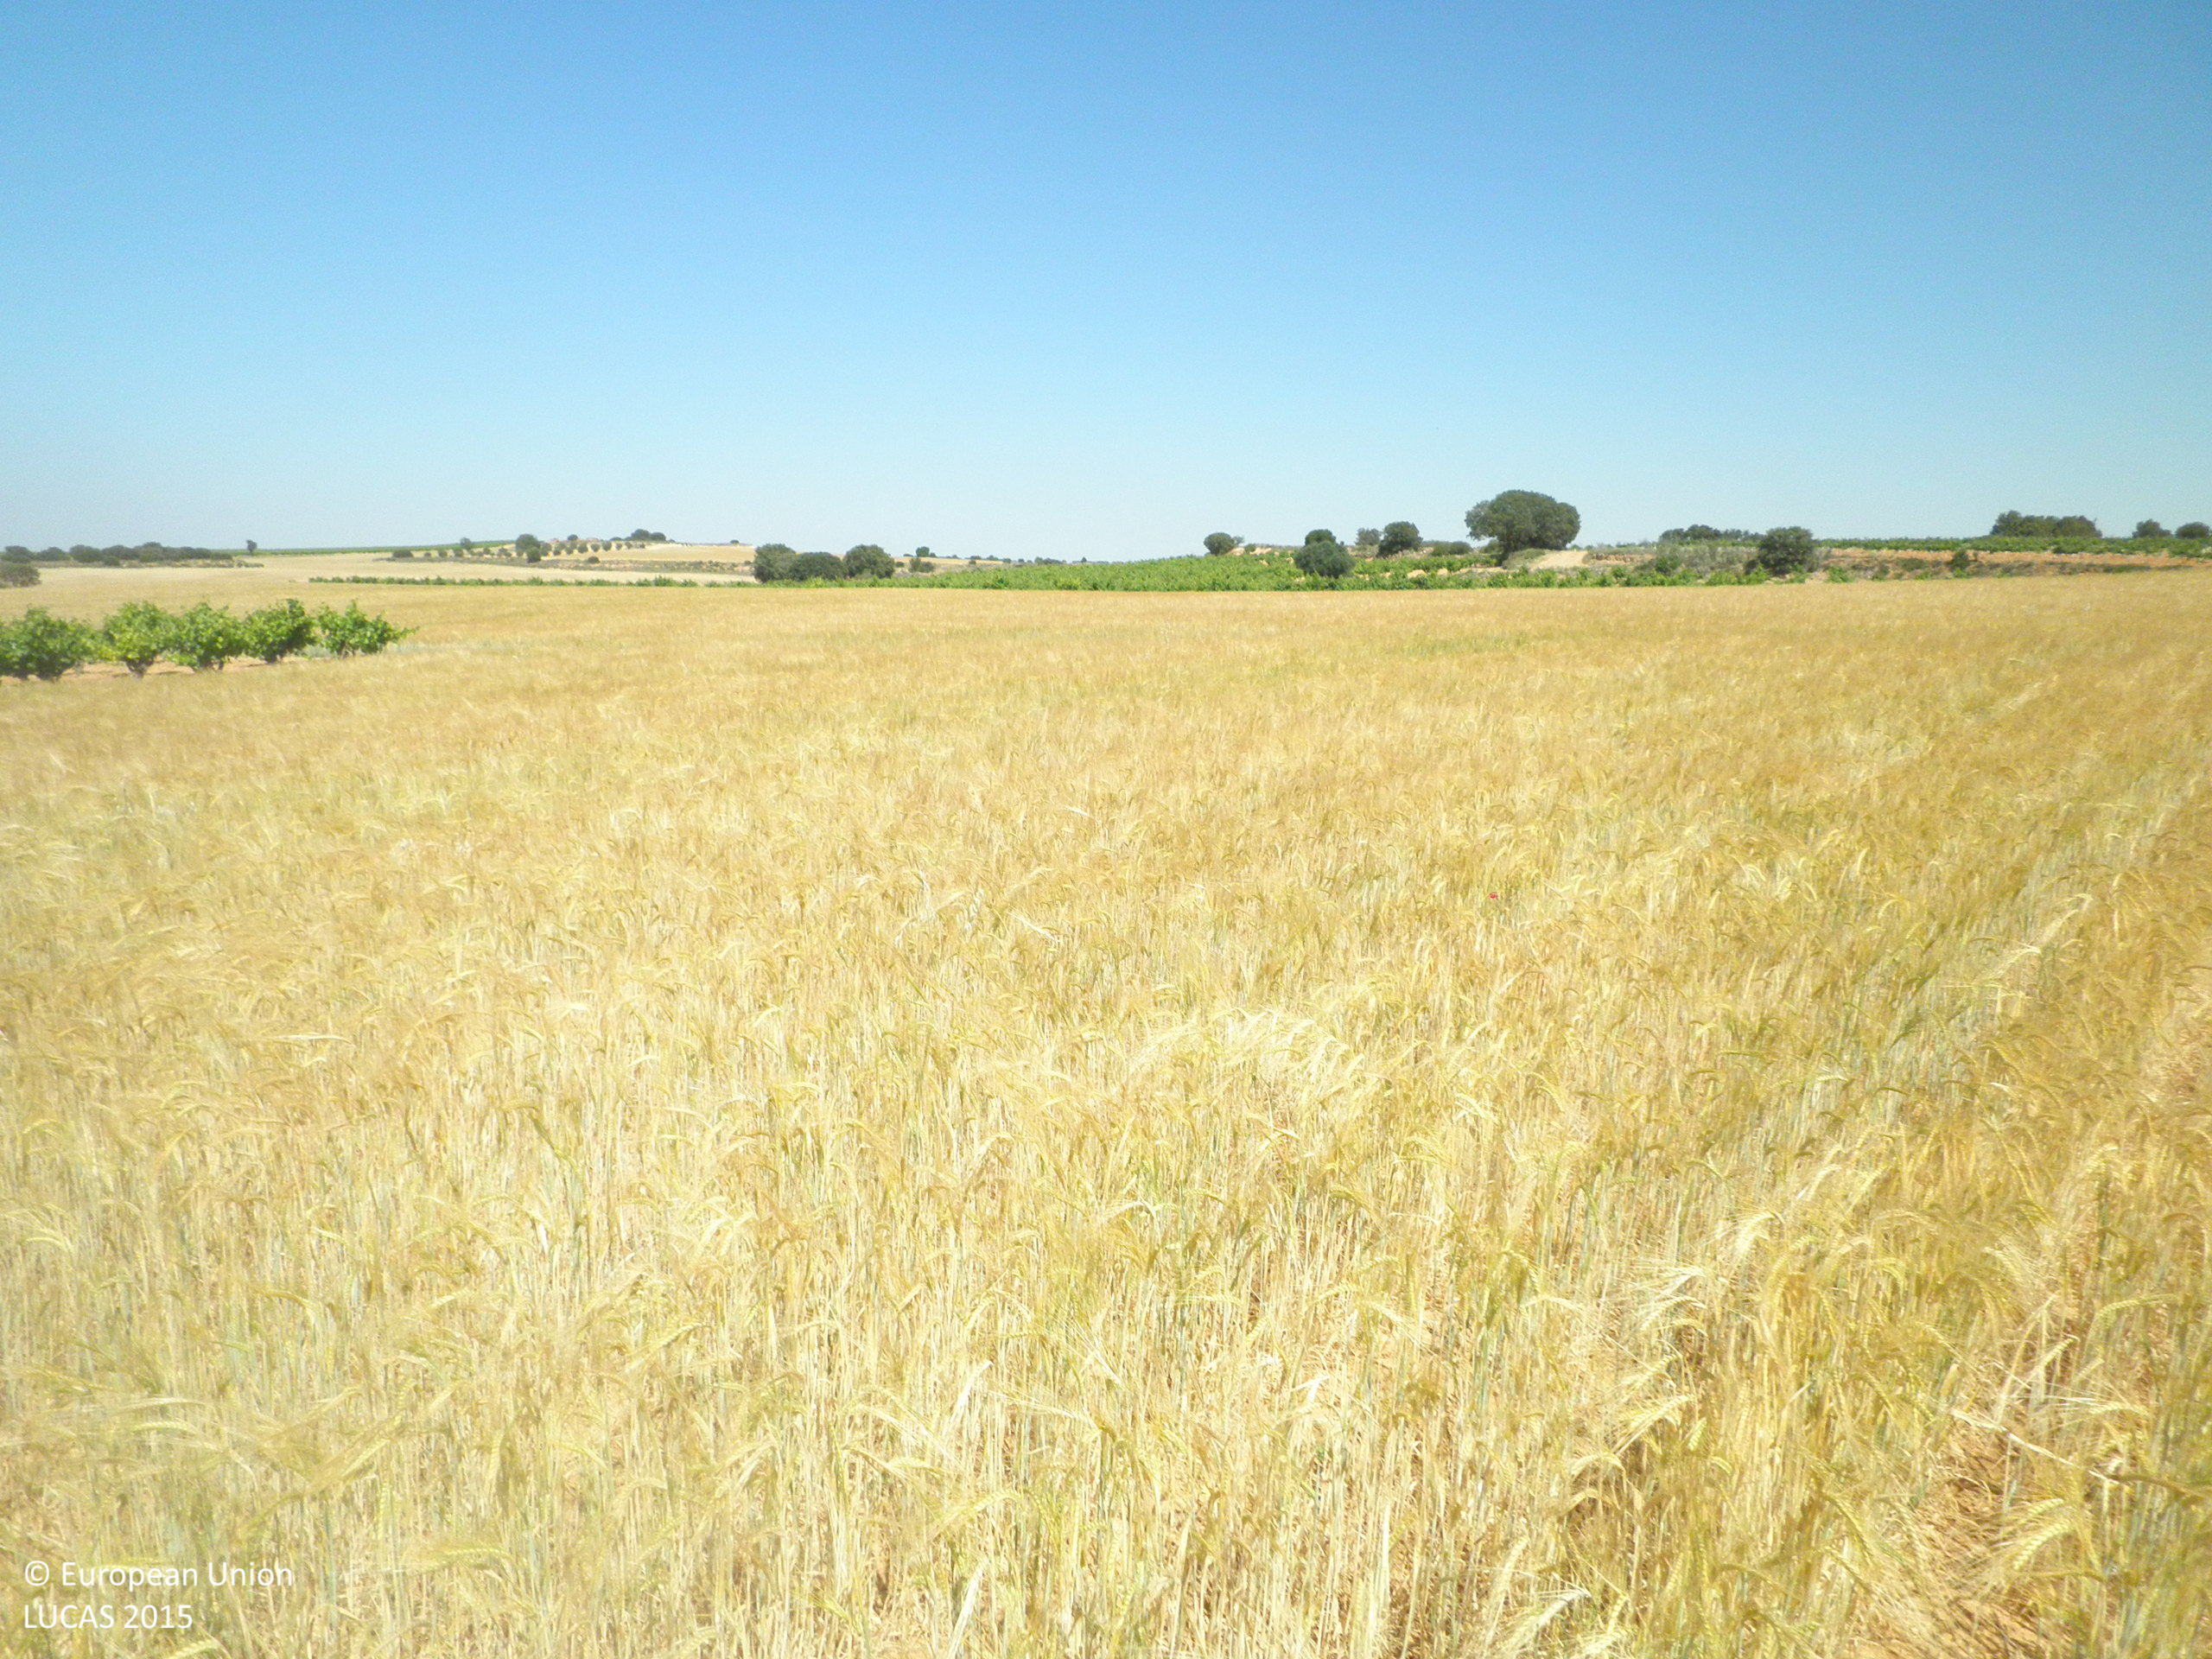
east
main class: Cropland
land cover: Barley
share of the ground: > 75 %
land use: Agriculture (excluding fallow land and kitchen gardens)
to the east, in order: Barley; Vineyards; Tracks; Vineyards; Grass margins
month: June
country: ES
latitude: 39.4073
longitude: -1.7928
